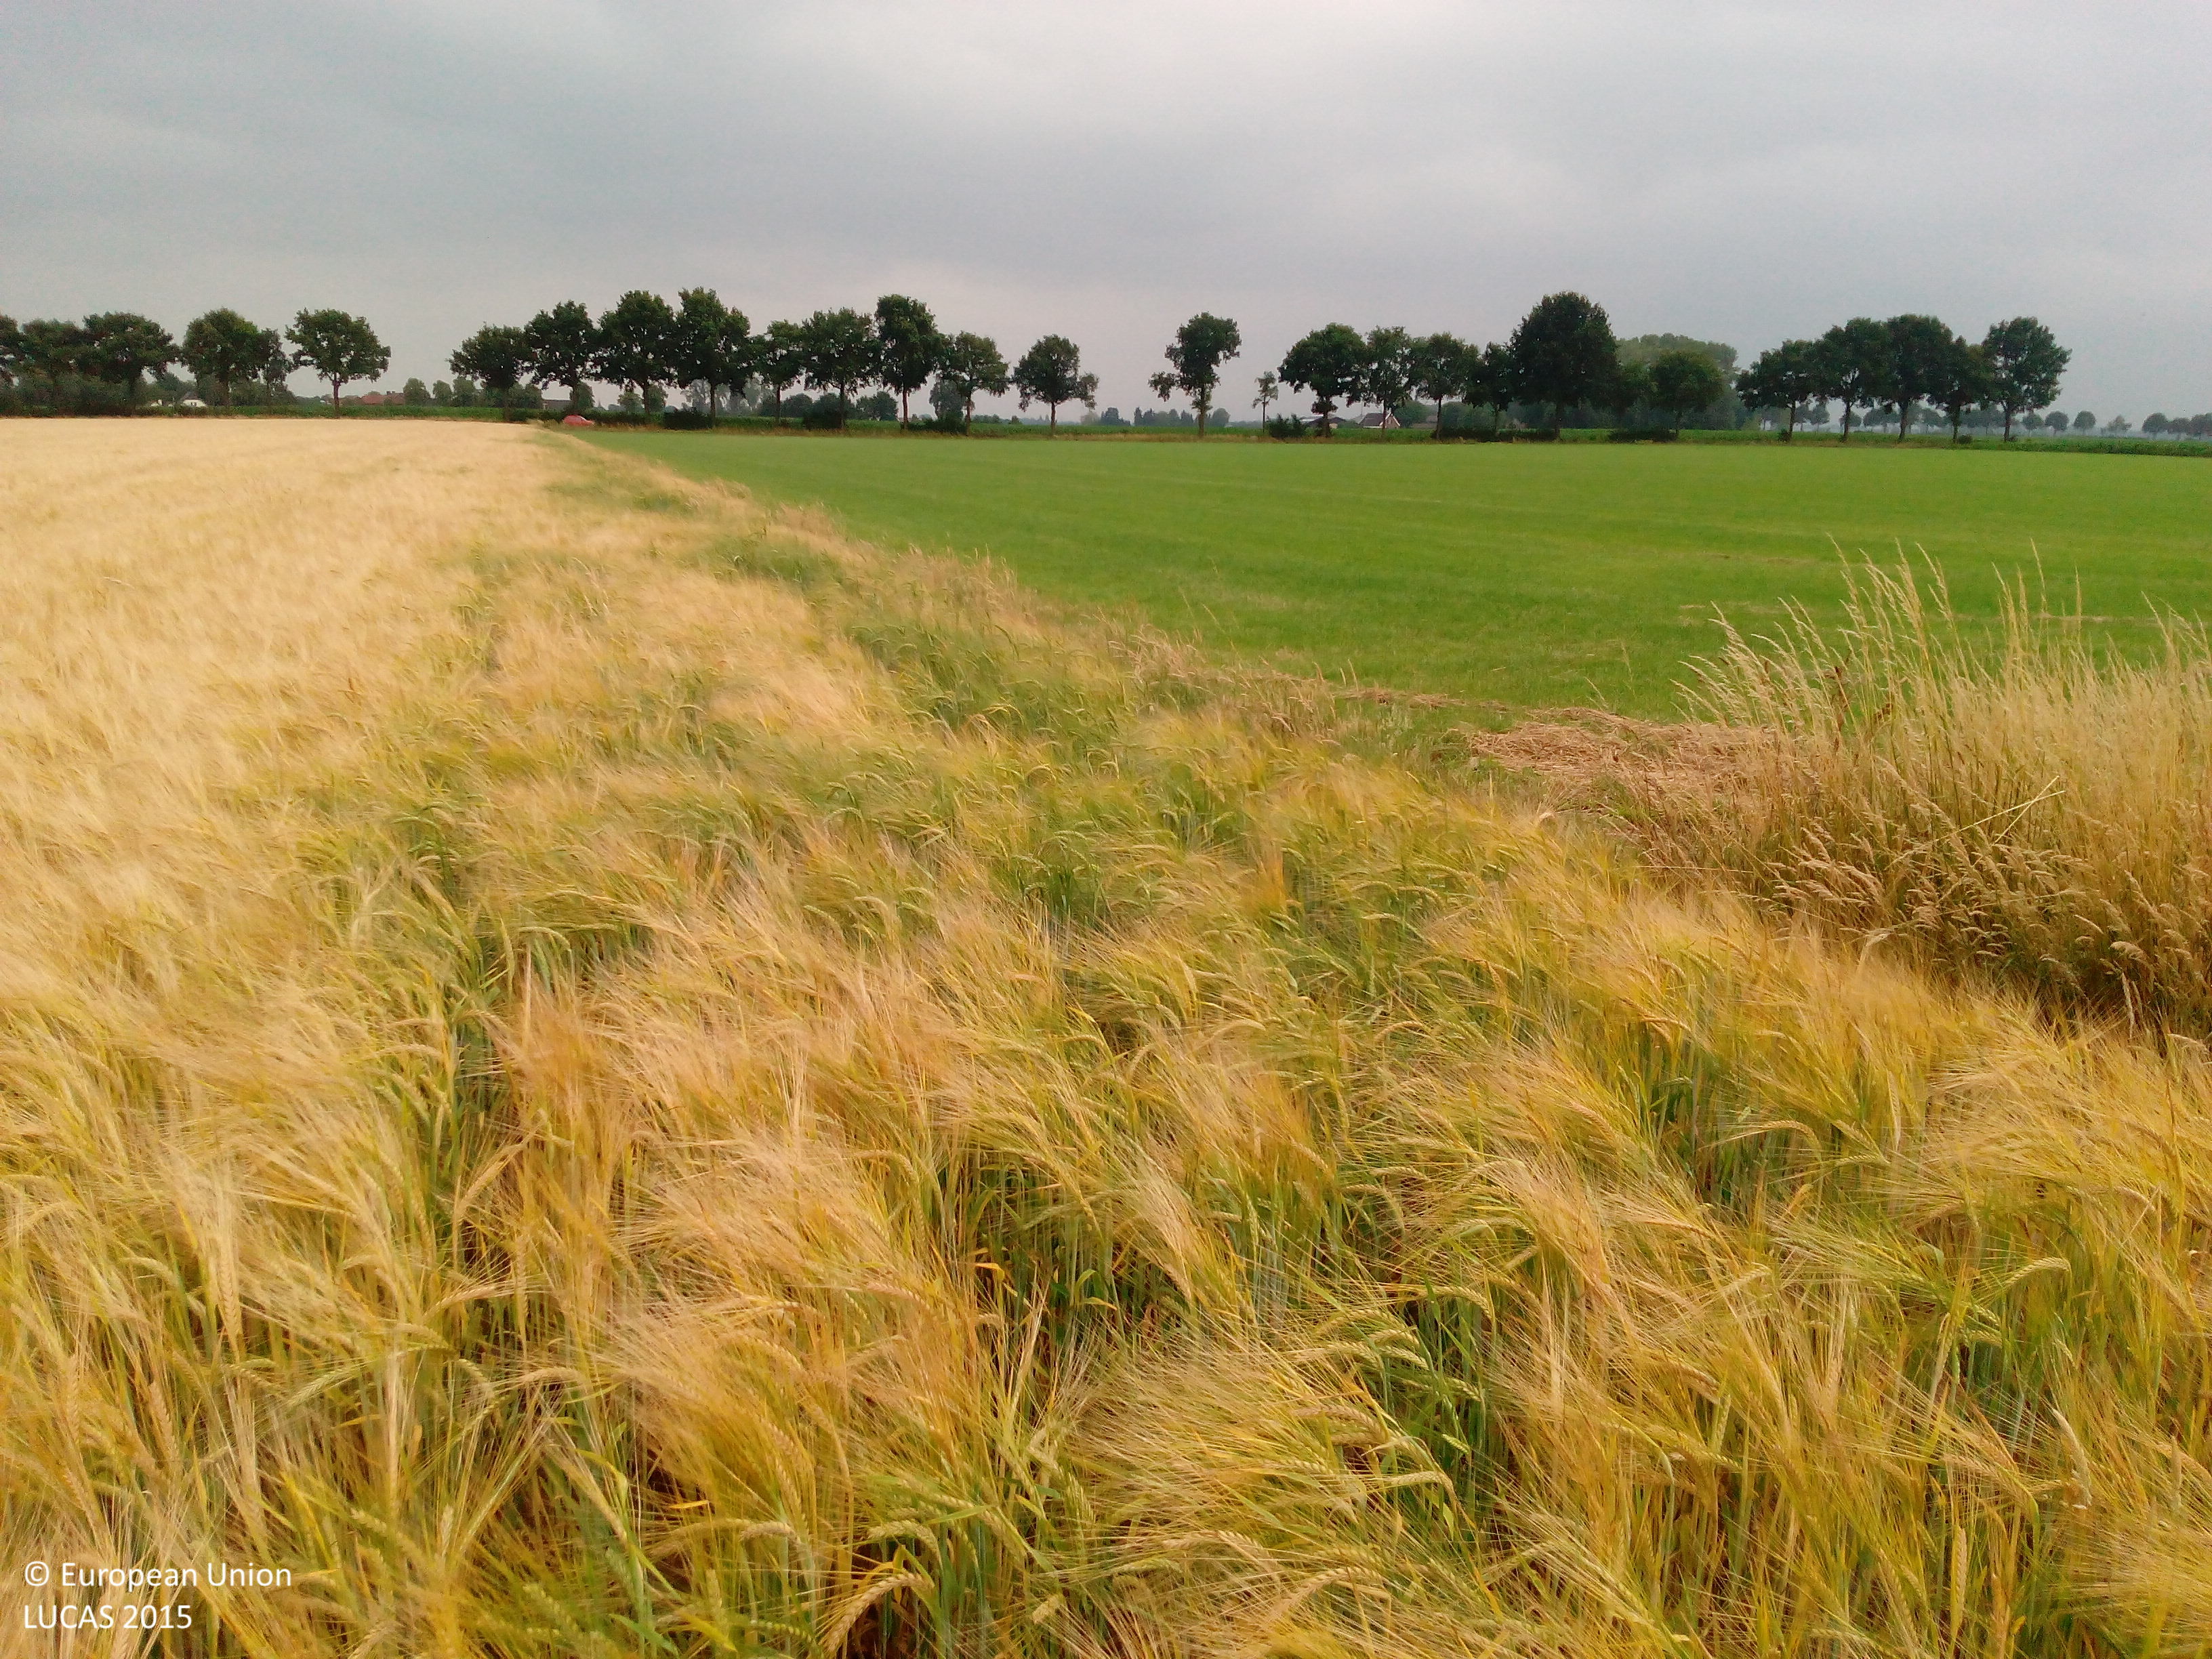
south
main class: Cropland
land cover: Barley
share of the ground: > 75 %
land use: Agriculture (excluding fallow land and kitchen gardens)
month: July
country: NL
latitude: 51.8878
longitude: 6.2944
